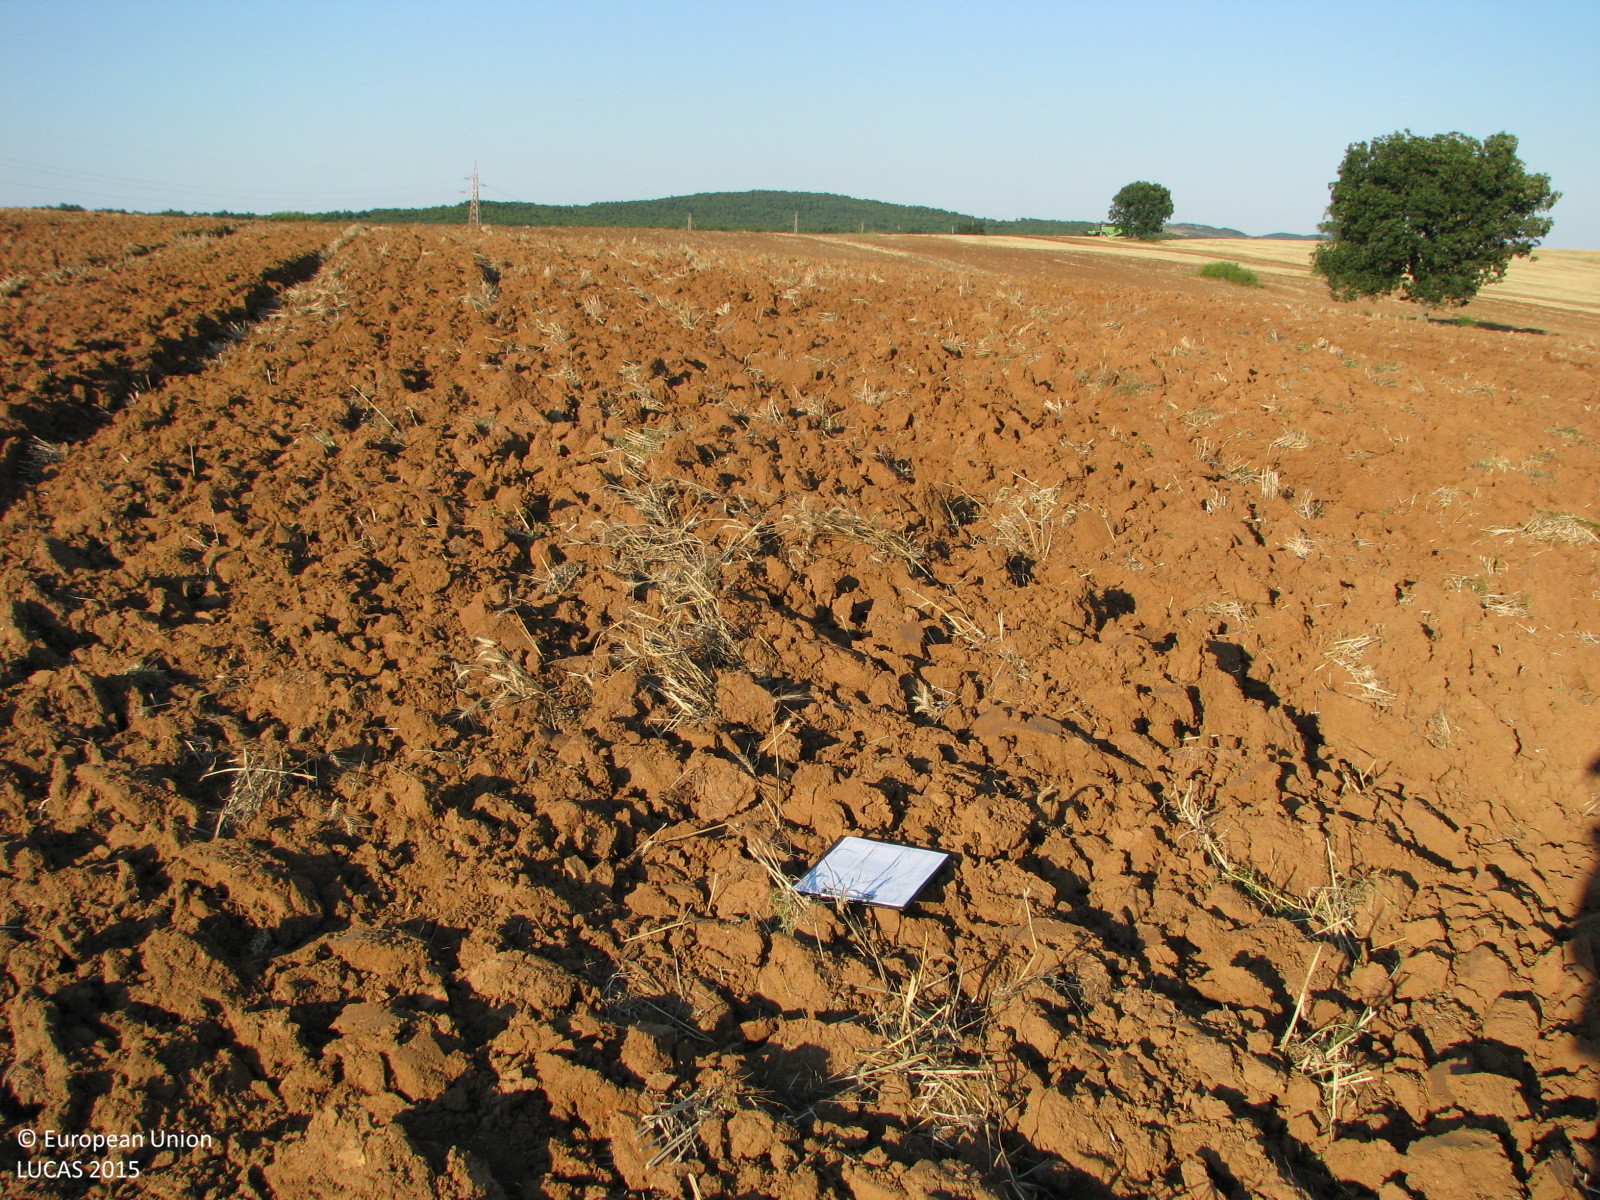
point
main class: Cropland
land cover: Common wheat
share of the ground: < 10 %
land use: Agriculture (excluding fallow land and kitchen gardens)
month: July
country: BG
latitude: 42.2079
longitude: 26.9475
